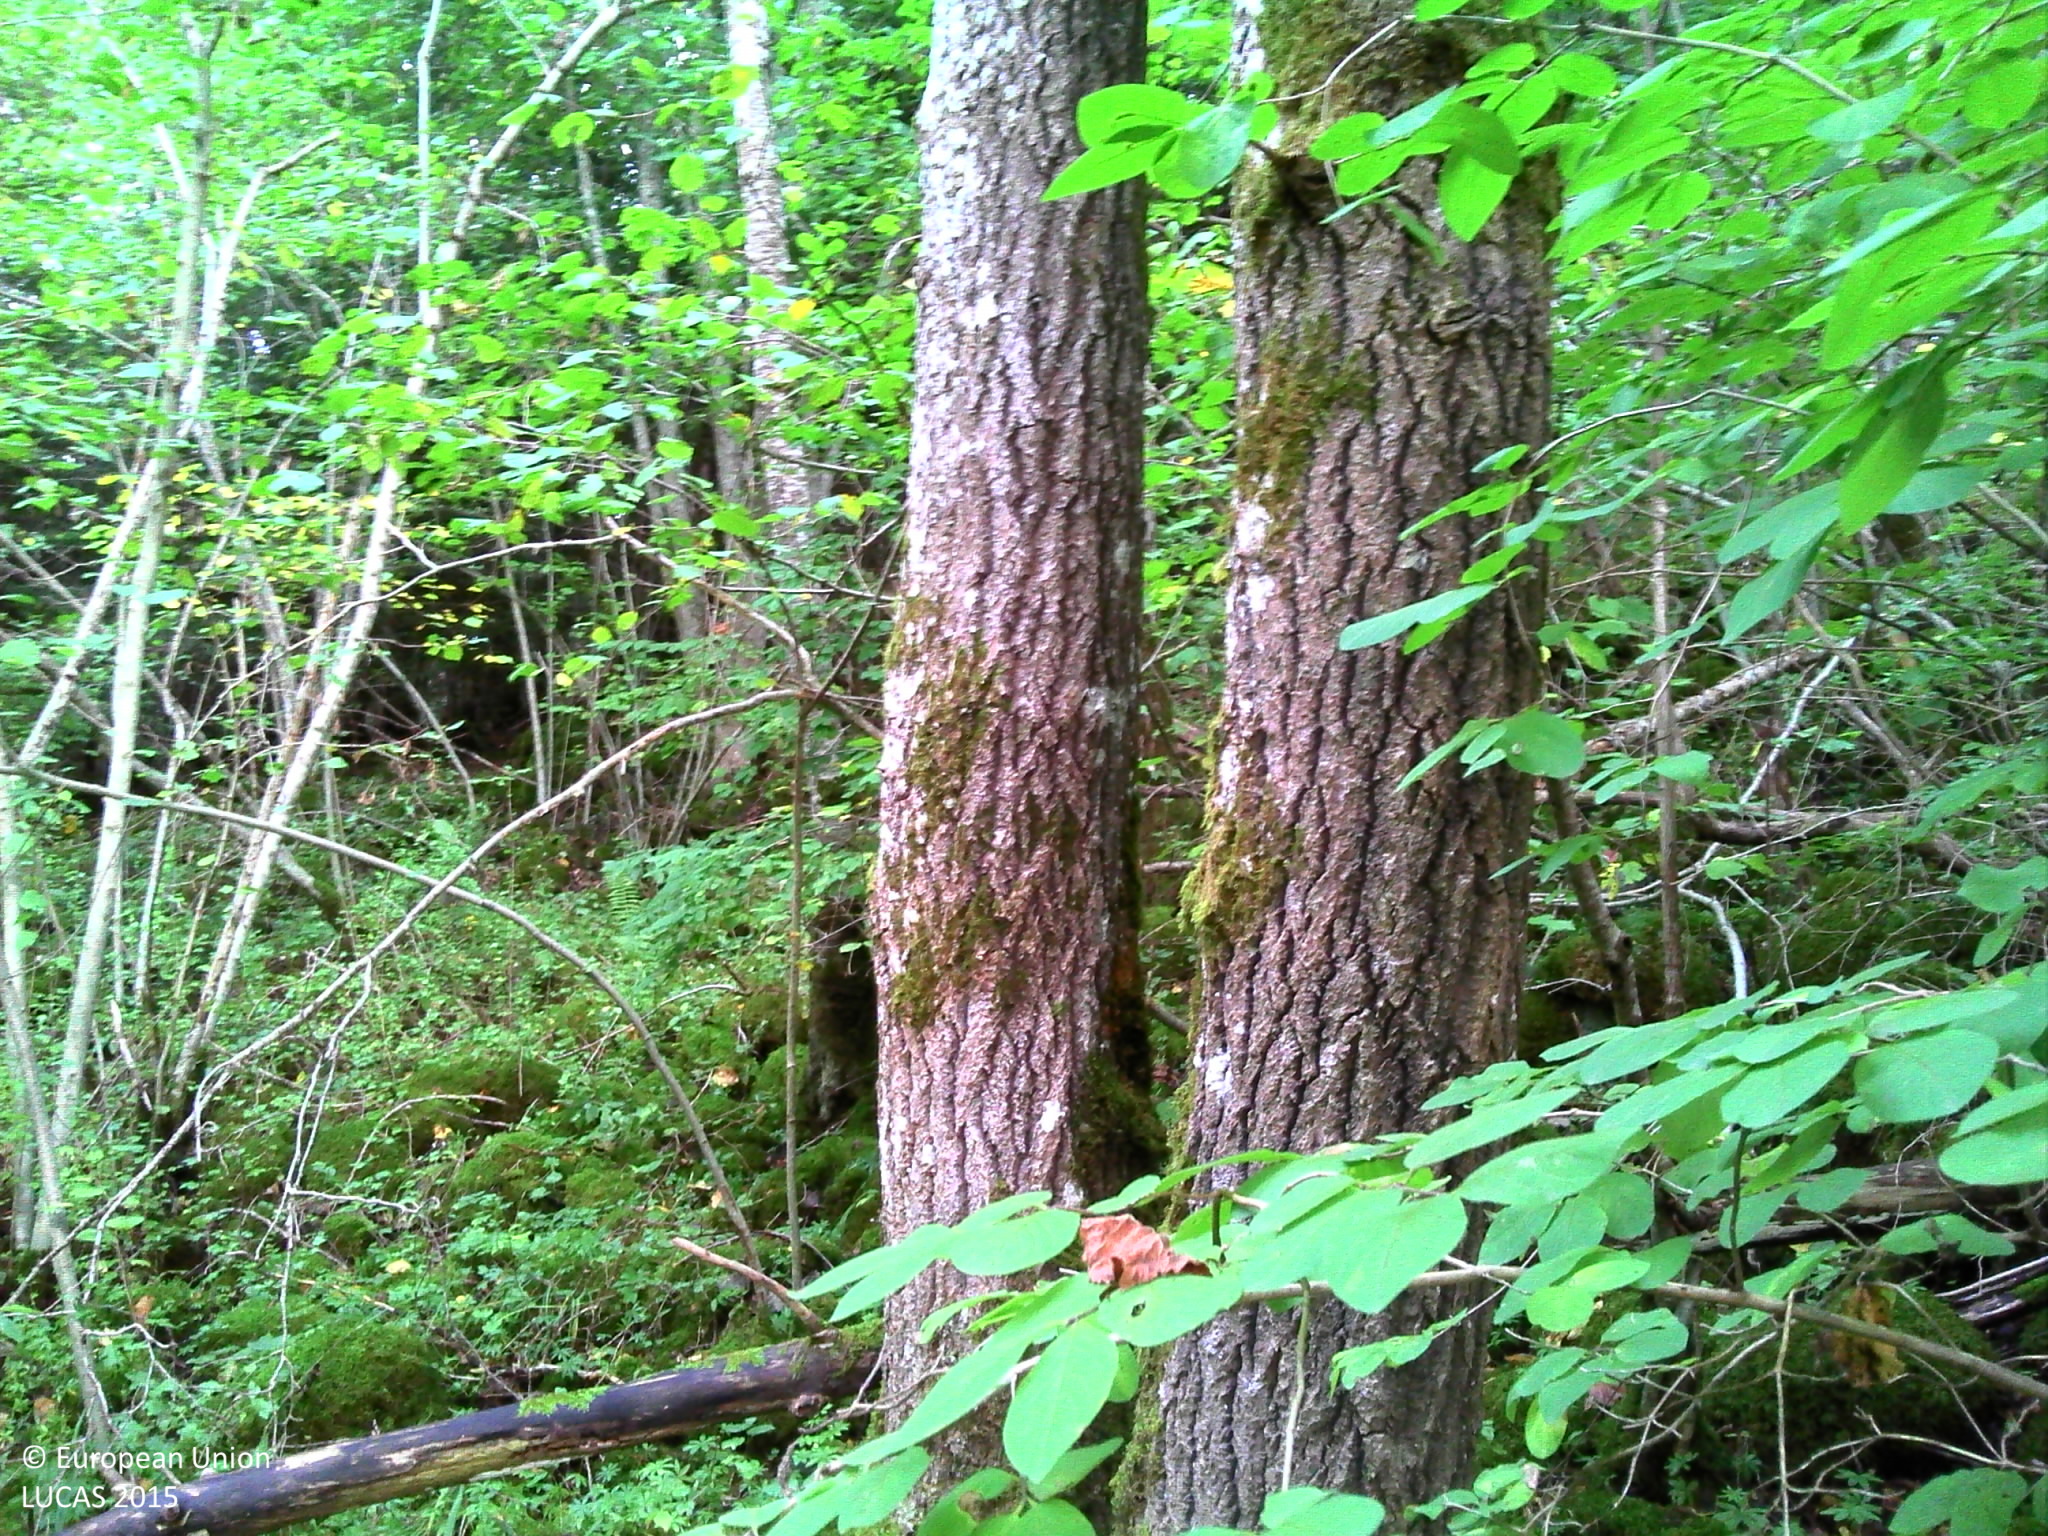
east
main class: Woodland
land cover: Broadleaved woodland
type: mesophytic deciduous forest
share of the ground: > 75 %
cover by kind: broadleaved forest trees 70 %, herbaceous plants 30 %
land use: Forestry
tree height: > 5 m
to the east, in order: Broadleaved woodland; Spruce dominated mixed woodland; Tracks; Broadleaved woodland; Spruce dominated mixed woodland; Broadleaved woodland; Spruce dominated mixed woodland; Tracks; Spruce dominated mixed woodland; Dry stone walls
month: September
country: FR
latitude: 45.8408
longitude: 2.8527
